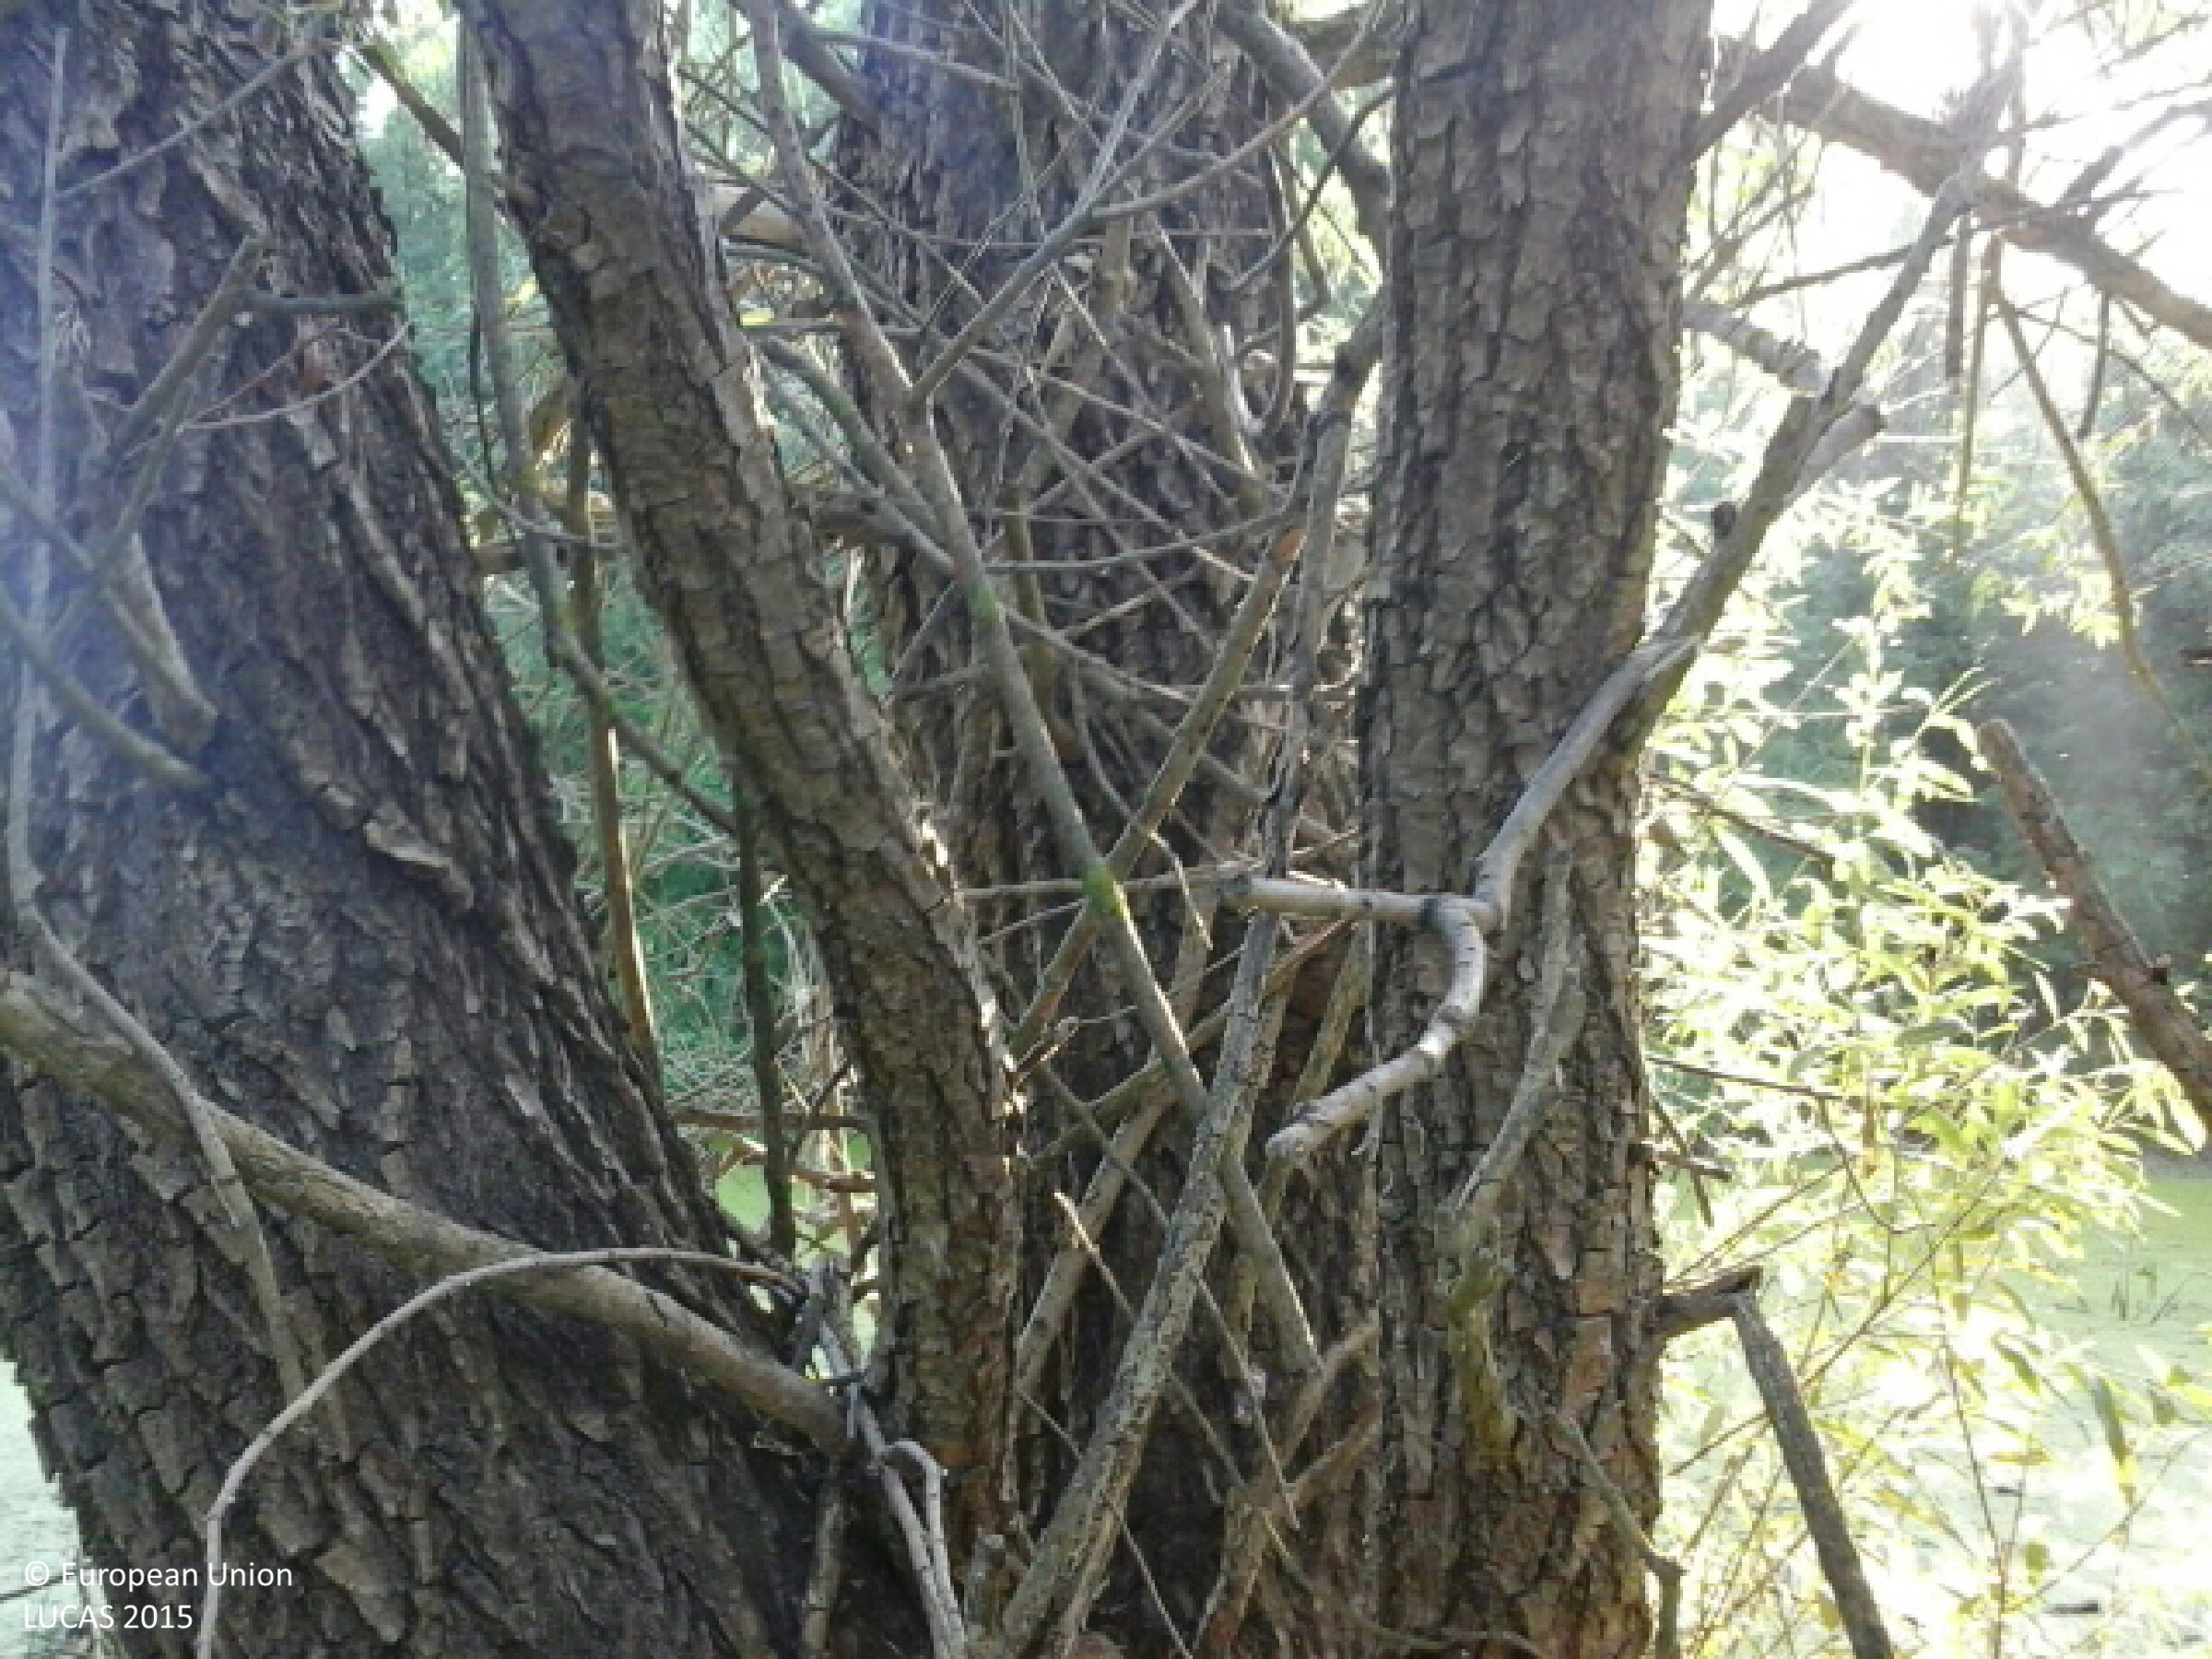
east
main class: Woodland
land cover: Broadleaved woodland
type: mesophytic deciduous forest
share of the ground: > 75 %
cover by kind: broadleaved forest trees 95 %, herbaceous plants 5 %
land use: Forestry
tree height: > 5 m
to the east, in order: Broadleaved woodland; Inland fresh running water; Broadleaved woodland
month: July
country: HU
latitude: 48.3527
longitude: 21.6130
